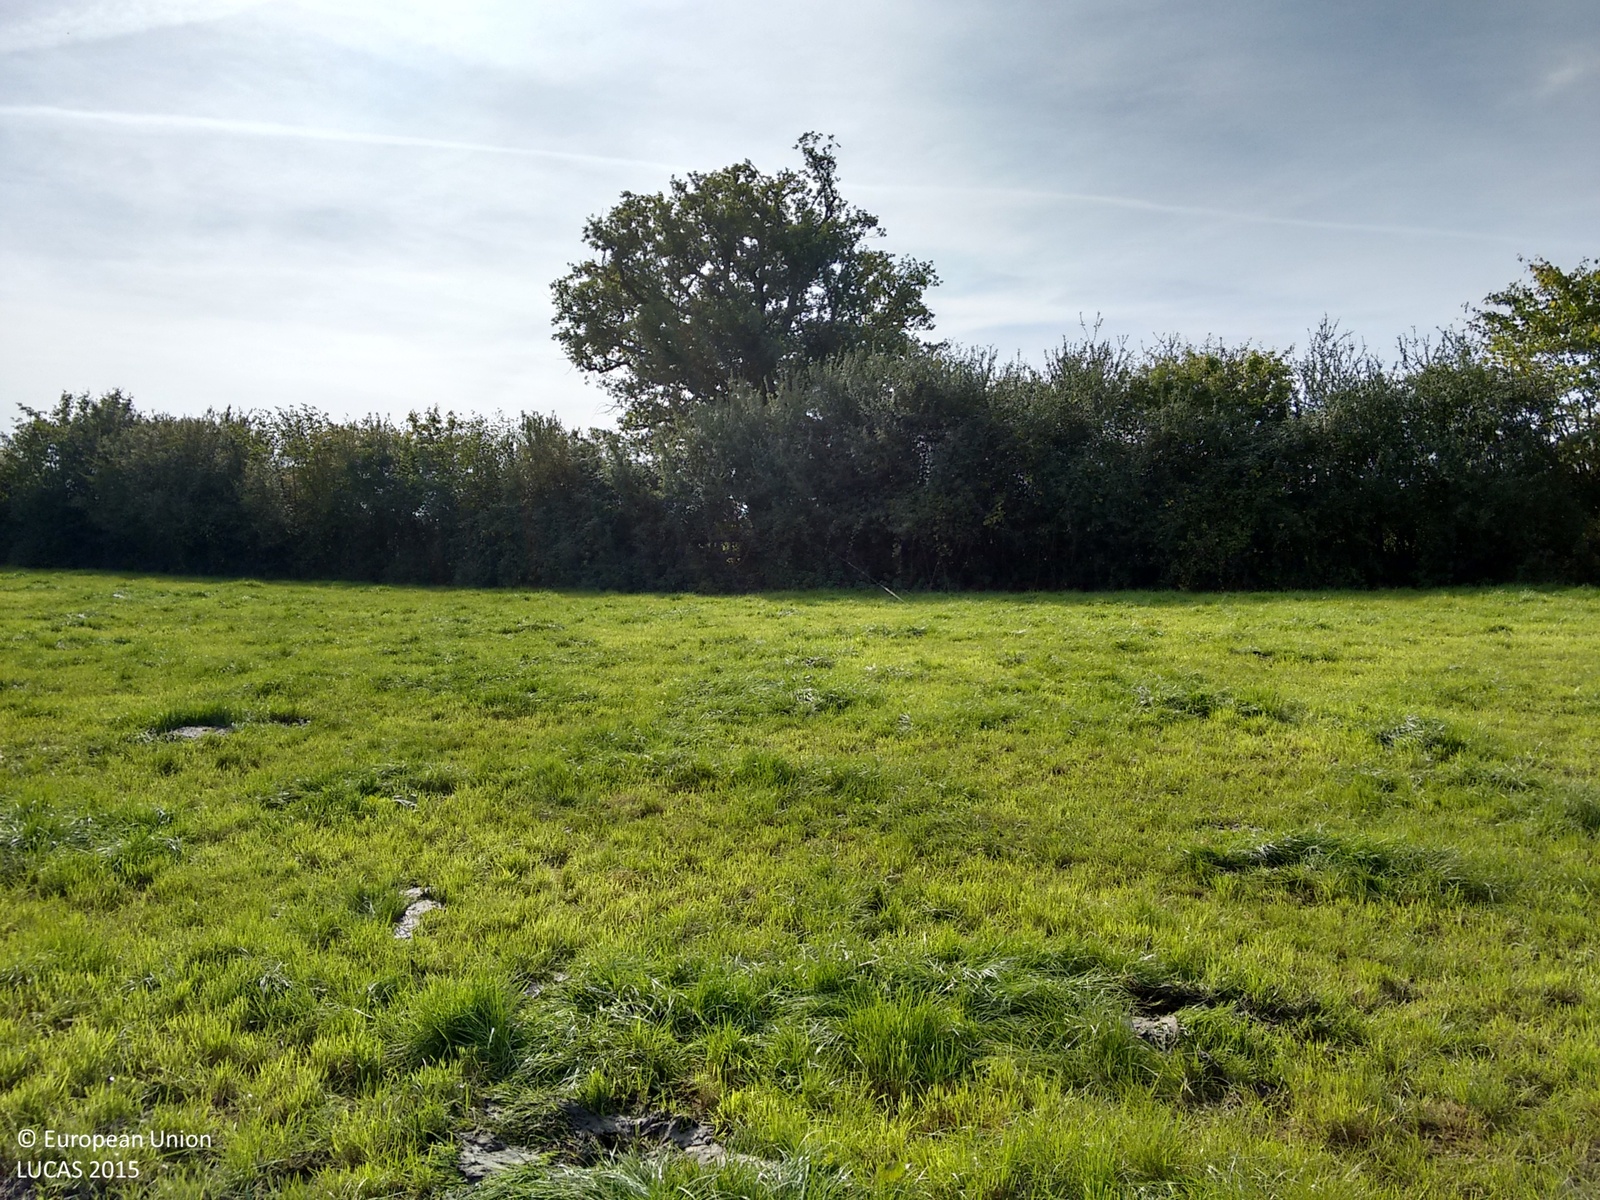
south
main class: Grassland
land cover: Grassland without tree/shrub cover
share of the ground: > 75 %
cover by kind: herbaceous plants 100 %
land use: Agriculture (excluding fallow land and kitchen gardens)
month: September
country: GB
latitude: 51.6313
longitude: -2.4174
